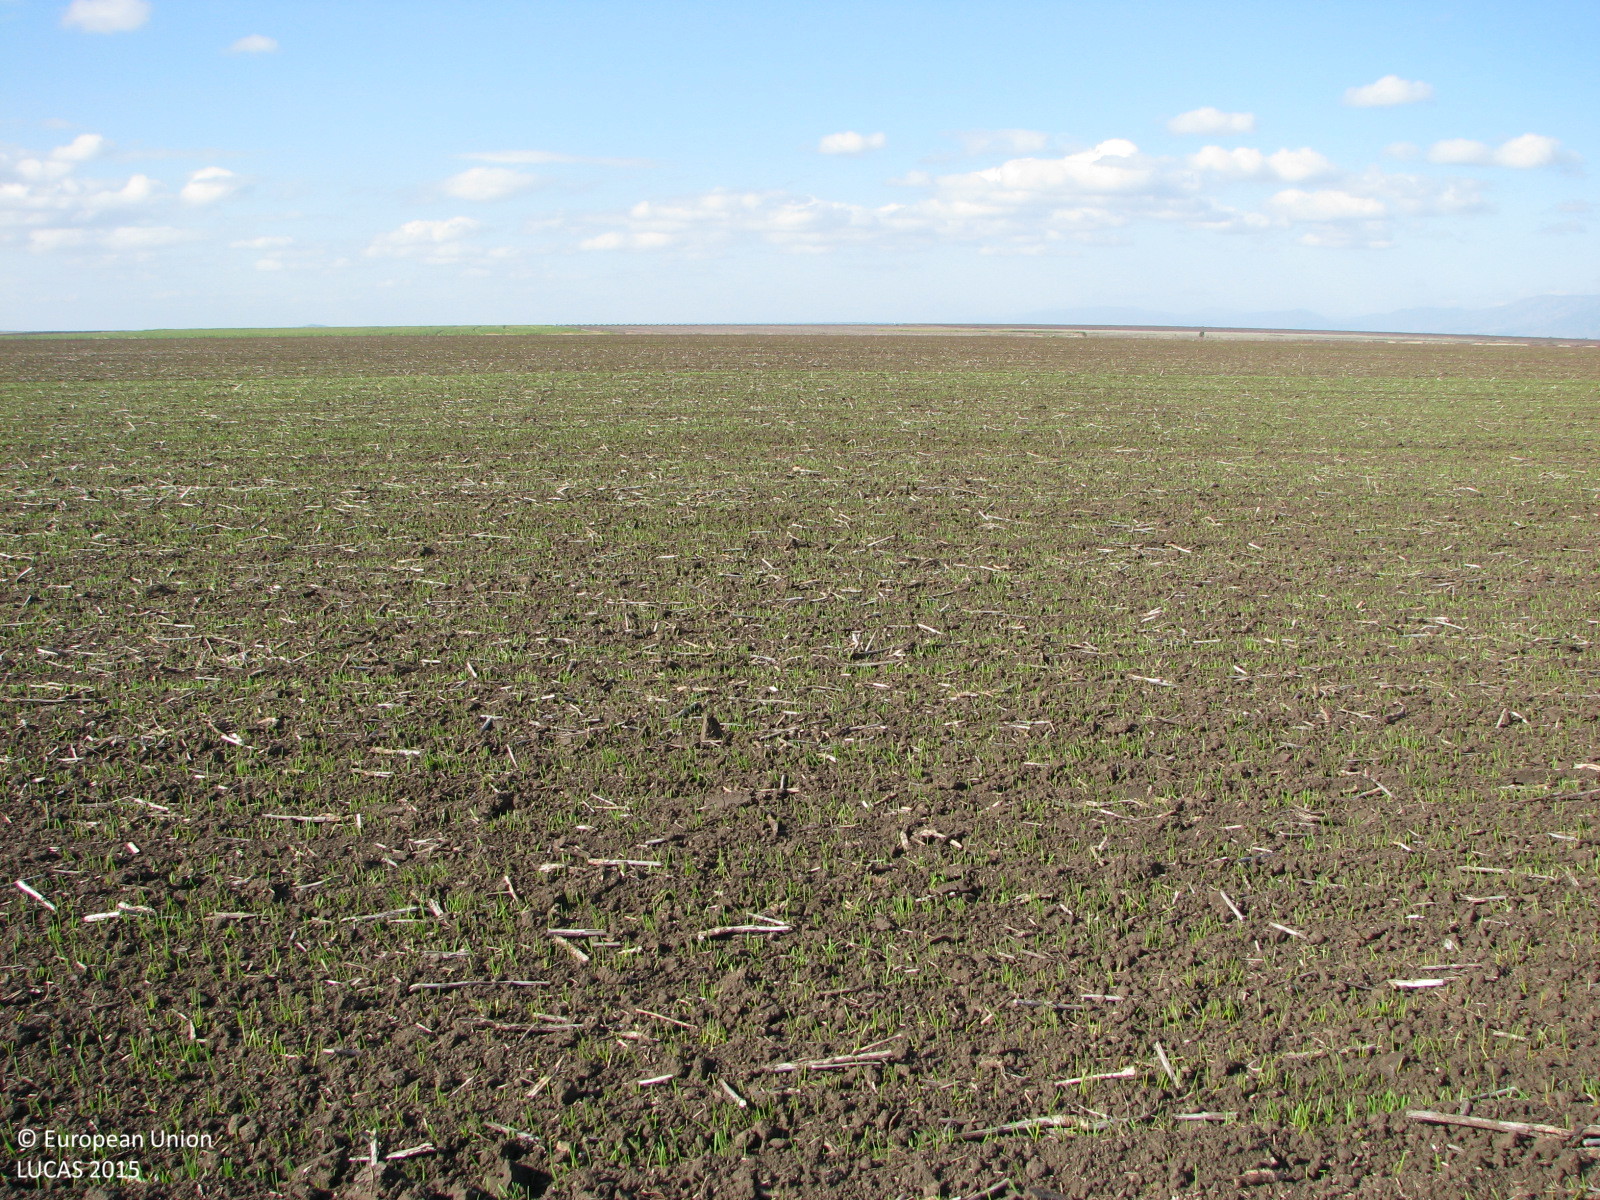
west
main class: Cropland
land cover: Common wheat
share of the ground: 10 - 25 %
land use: Agriculture (excluding fallow land and kitchen gardens)
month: November
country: BG
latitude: 42.5664
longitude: 26.6764
